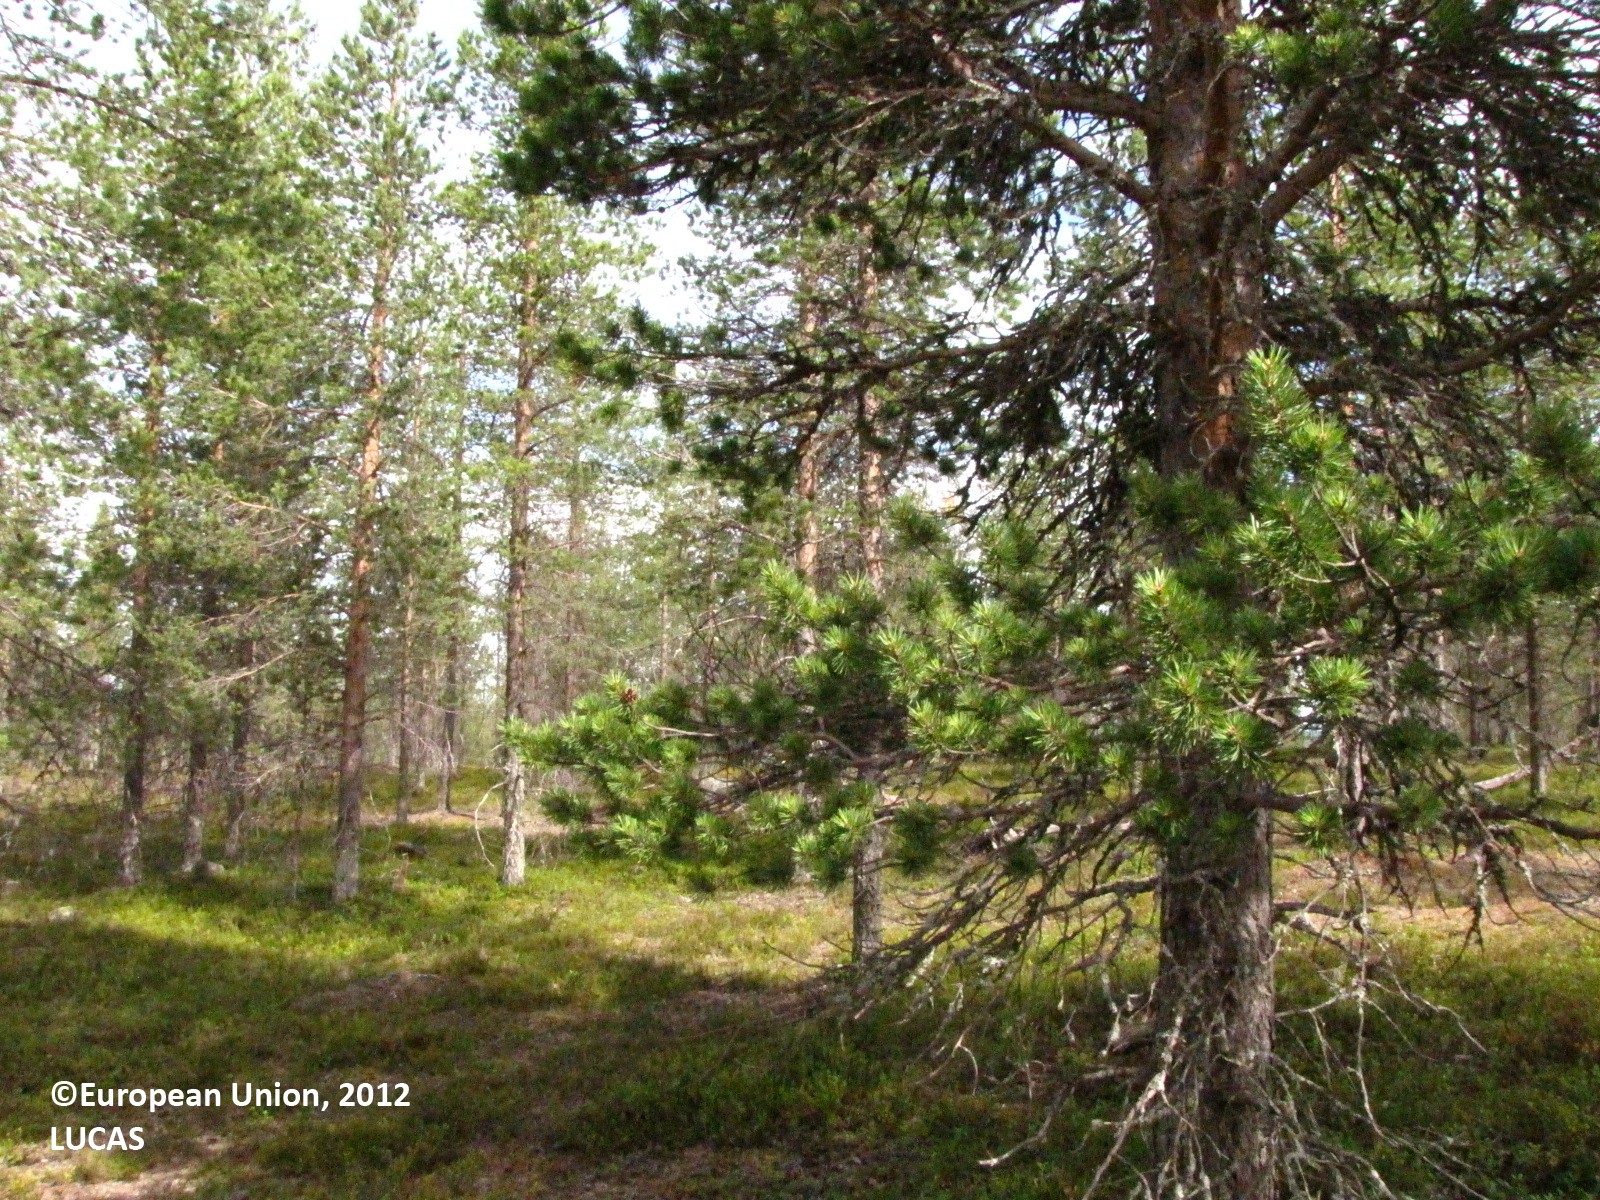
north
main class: Woodland
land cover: Pine dominated coniferous woodland
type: boreal forest
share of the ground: 50 - 75 %
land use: Forestry
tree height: > 5 m
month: July
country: FI
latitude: 66.6439
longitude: 25.1315
